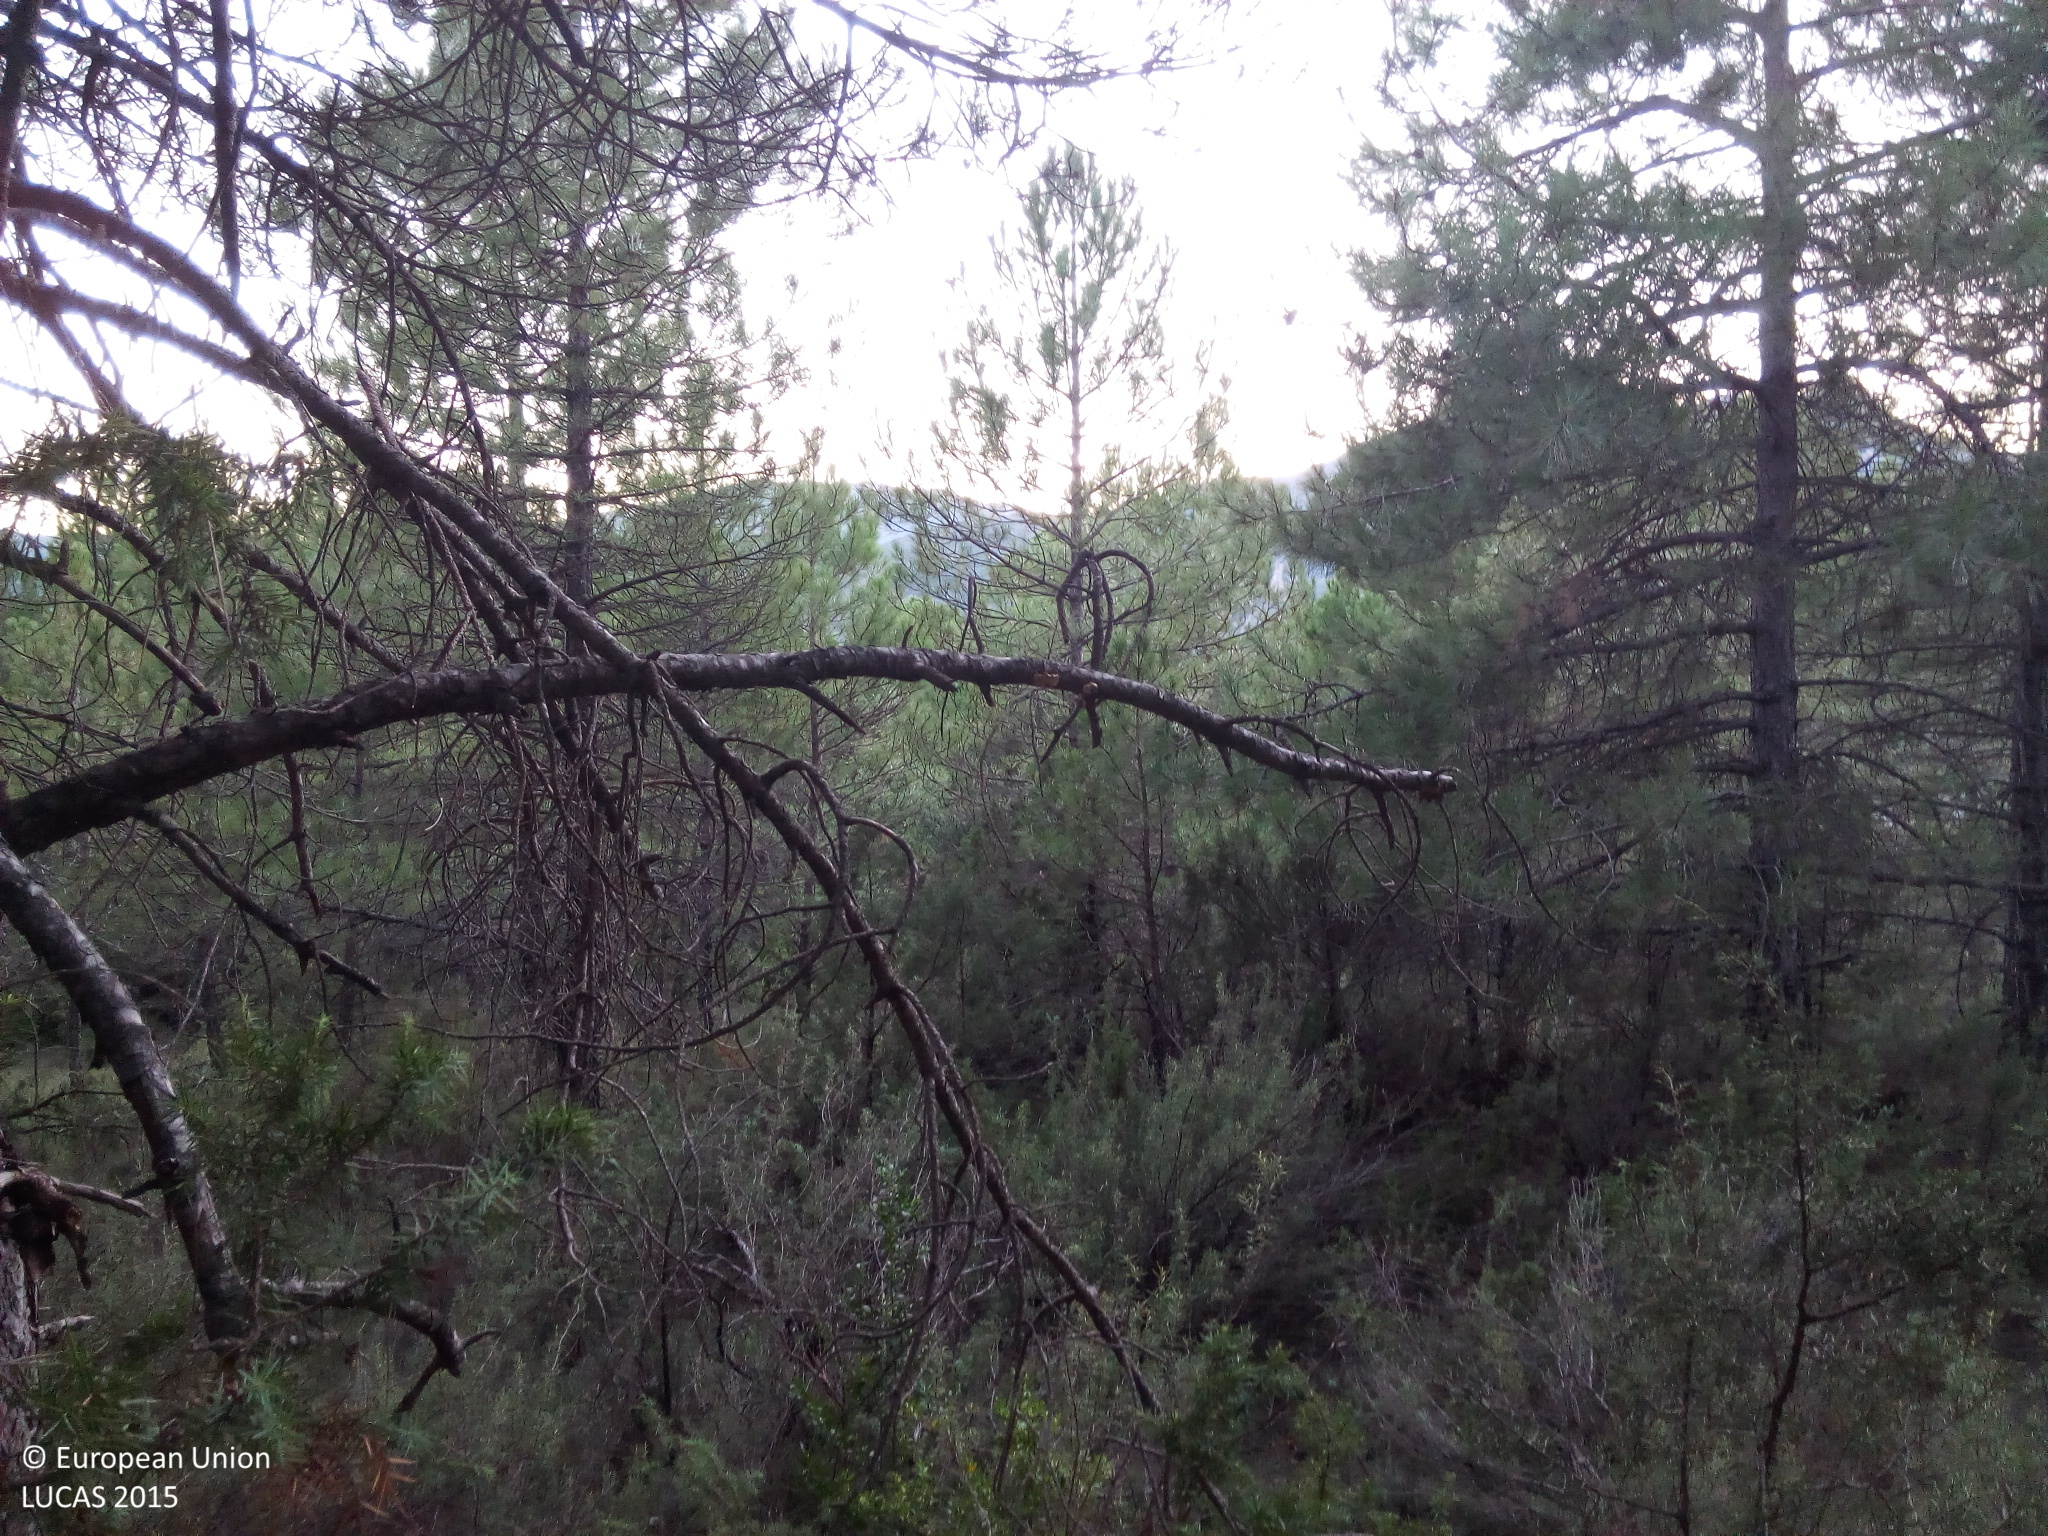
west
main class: Woodland
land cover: Pine dominated coniferous woodland
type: coniferous forest of the mediterranean region
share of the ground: > 75 %
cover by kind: coniferous forest trees 95 %, shrubs 5 %
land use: Forestry
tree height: > 5 m
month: August
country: ES
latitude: 42.5164
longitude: 0.1311
